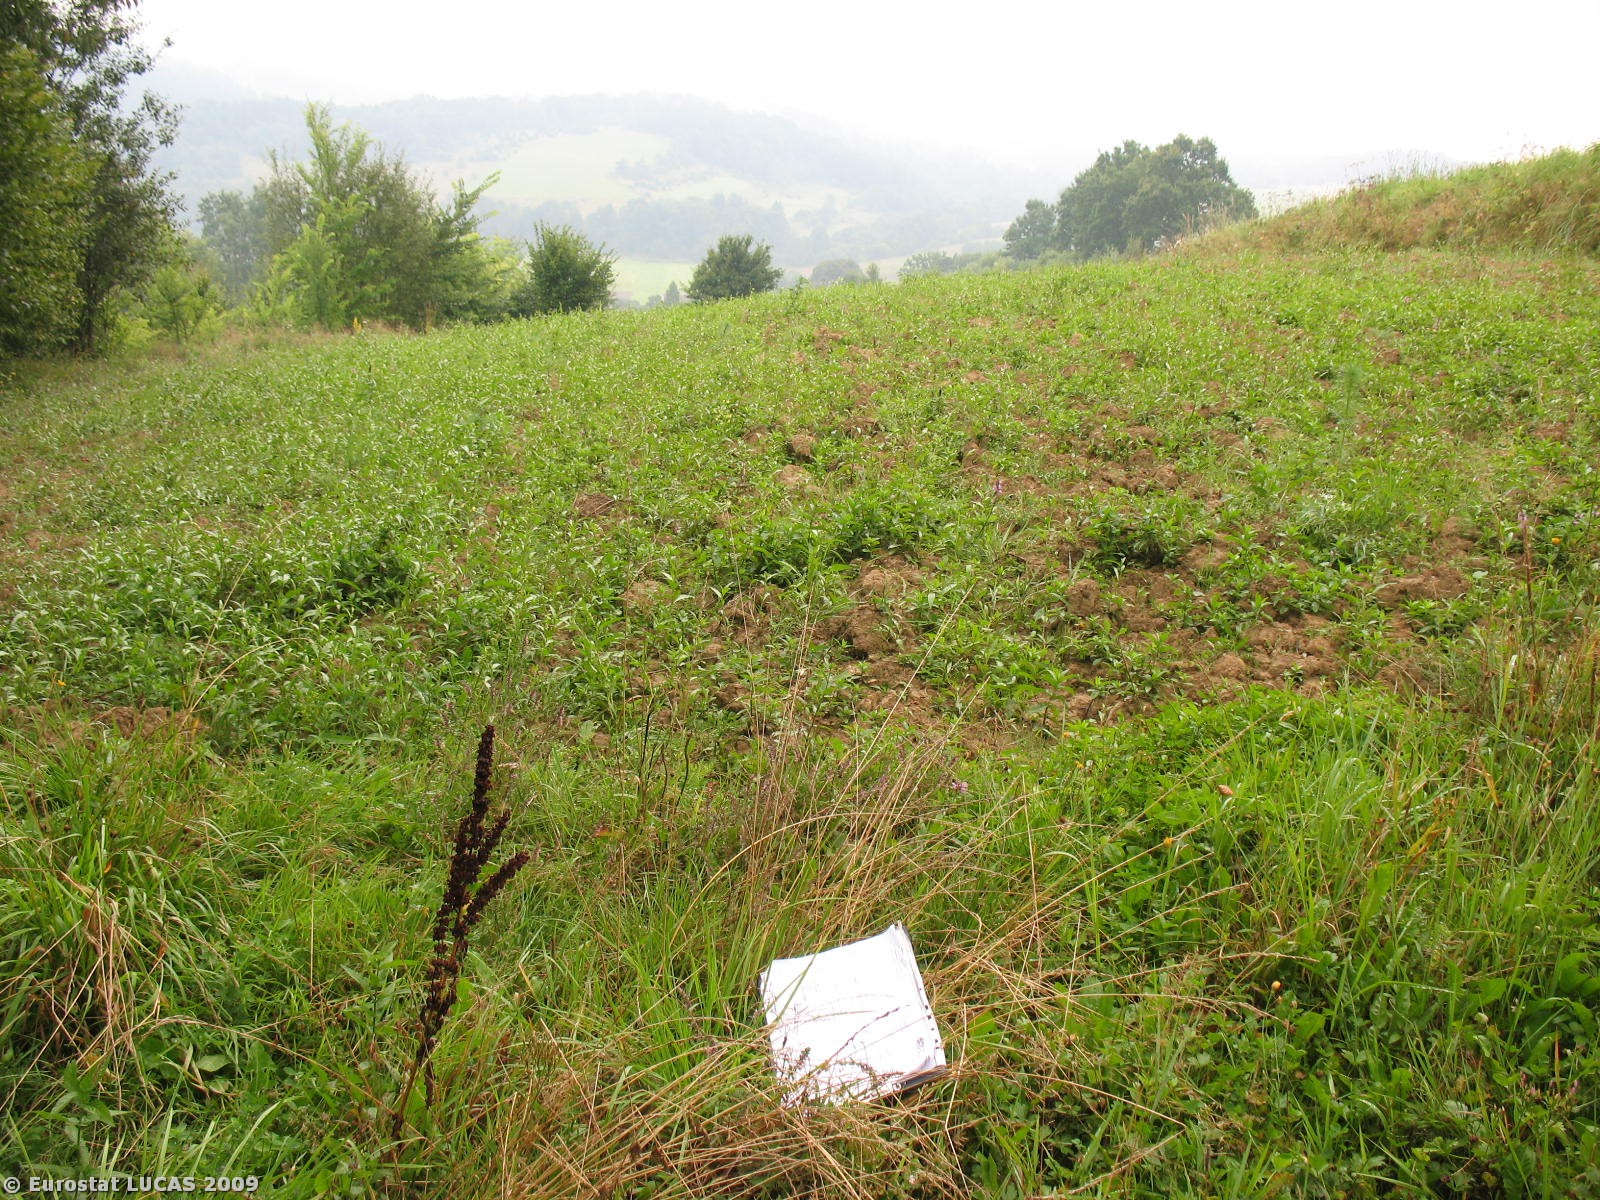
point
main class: Grassland
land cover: Spontaneously vegetated surfaces
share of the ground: > 75 %
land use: Fallow land
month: August
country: PL
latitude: 49.4076
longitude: 22.2854
